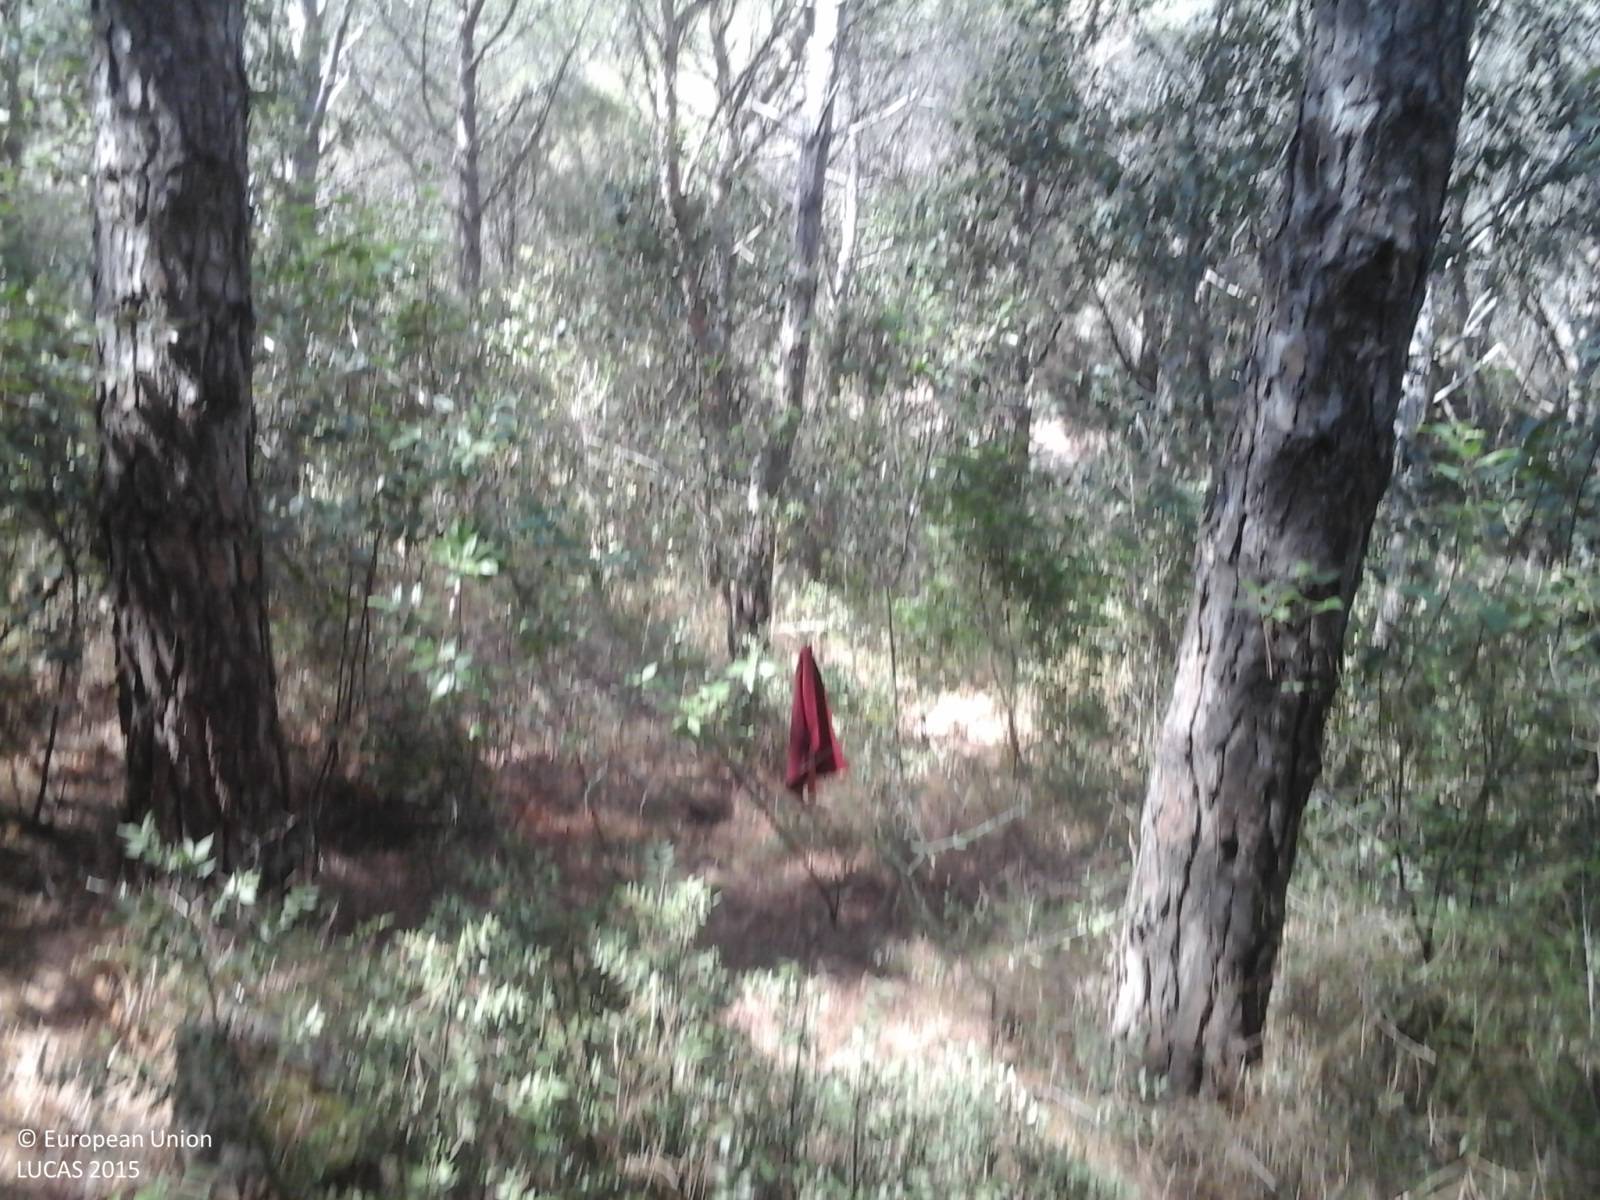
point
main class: Woodland
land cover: Pine dominated coniferous woodland
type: coniferous forest of the mediterranean region
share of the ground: 10 - 25 %
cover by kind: herbaceous plants 60 %, shrubs 30 %, coniferous forest trees 10 %
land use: Semi-natural and natural areas not in use
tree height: > 5 m
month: July
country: IT
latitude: 41.1686
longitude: 9.1813
